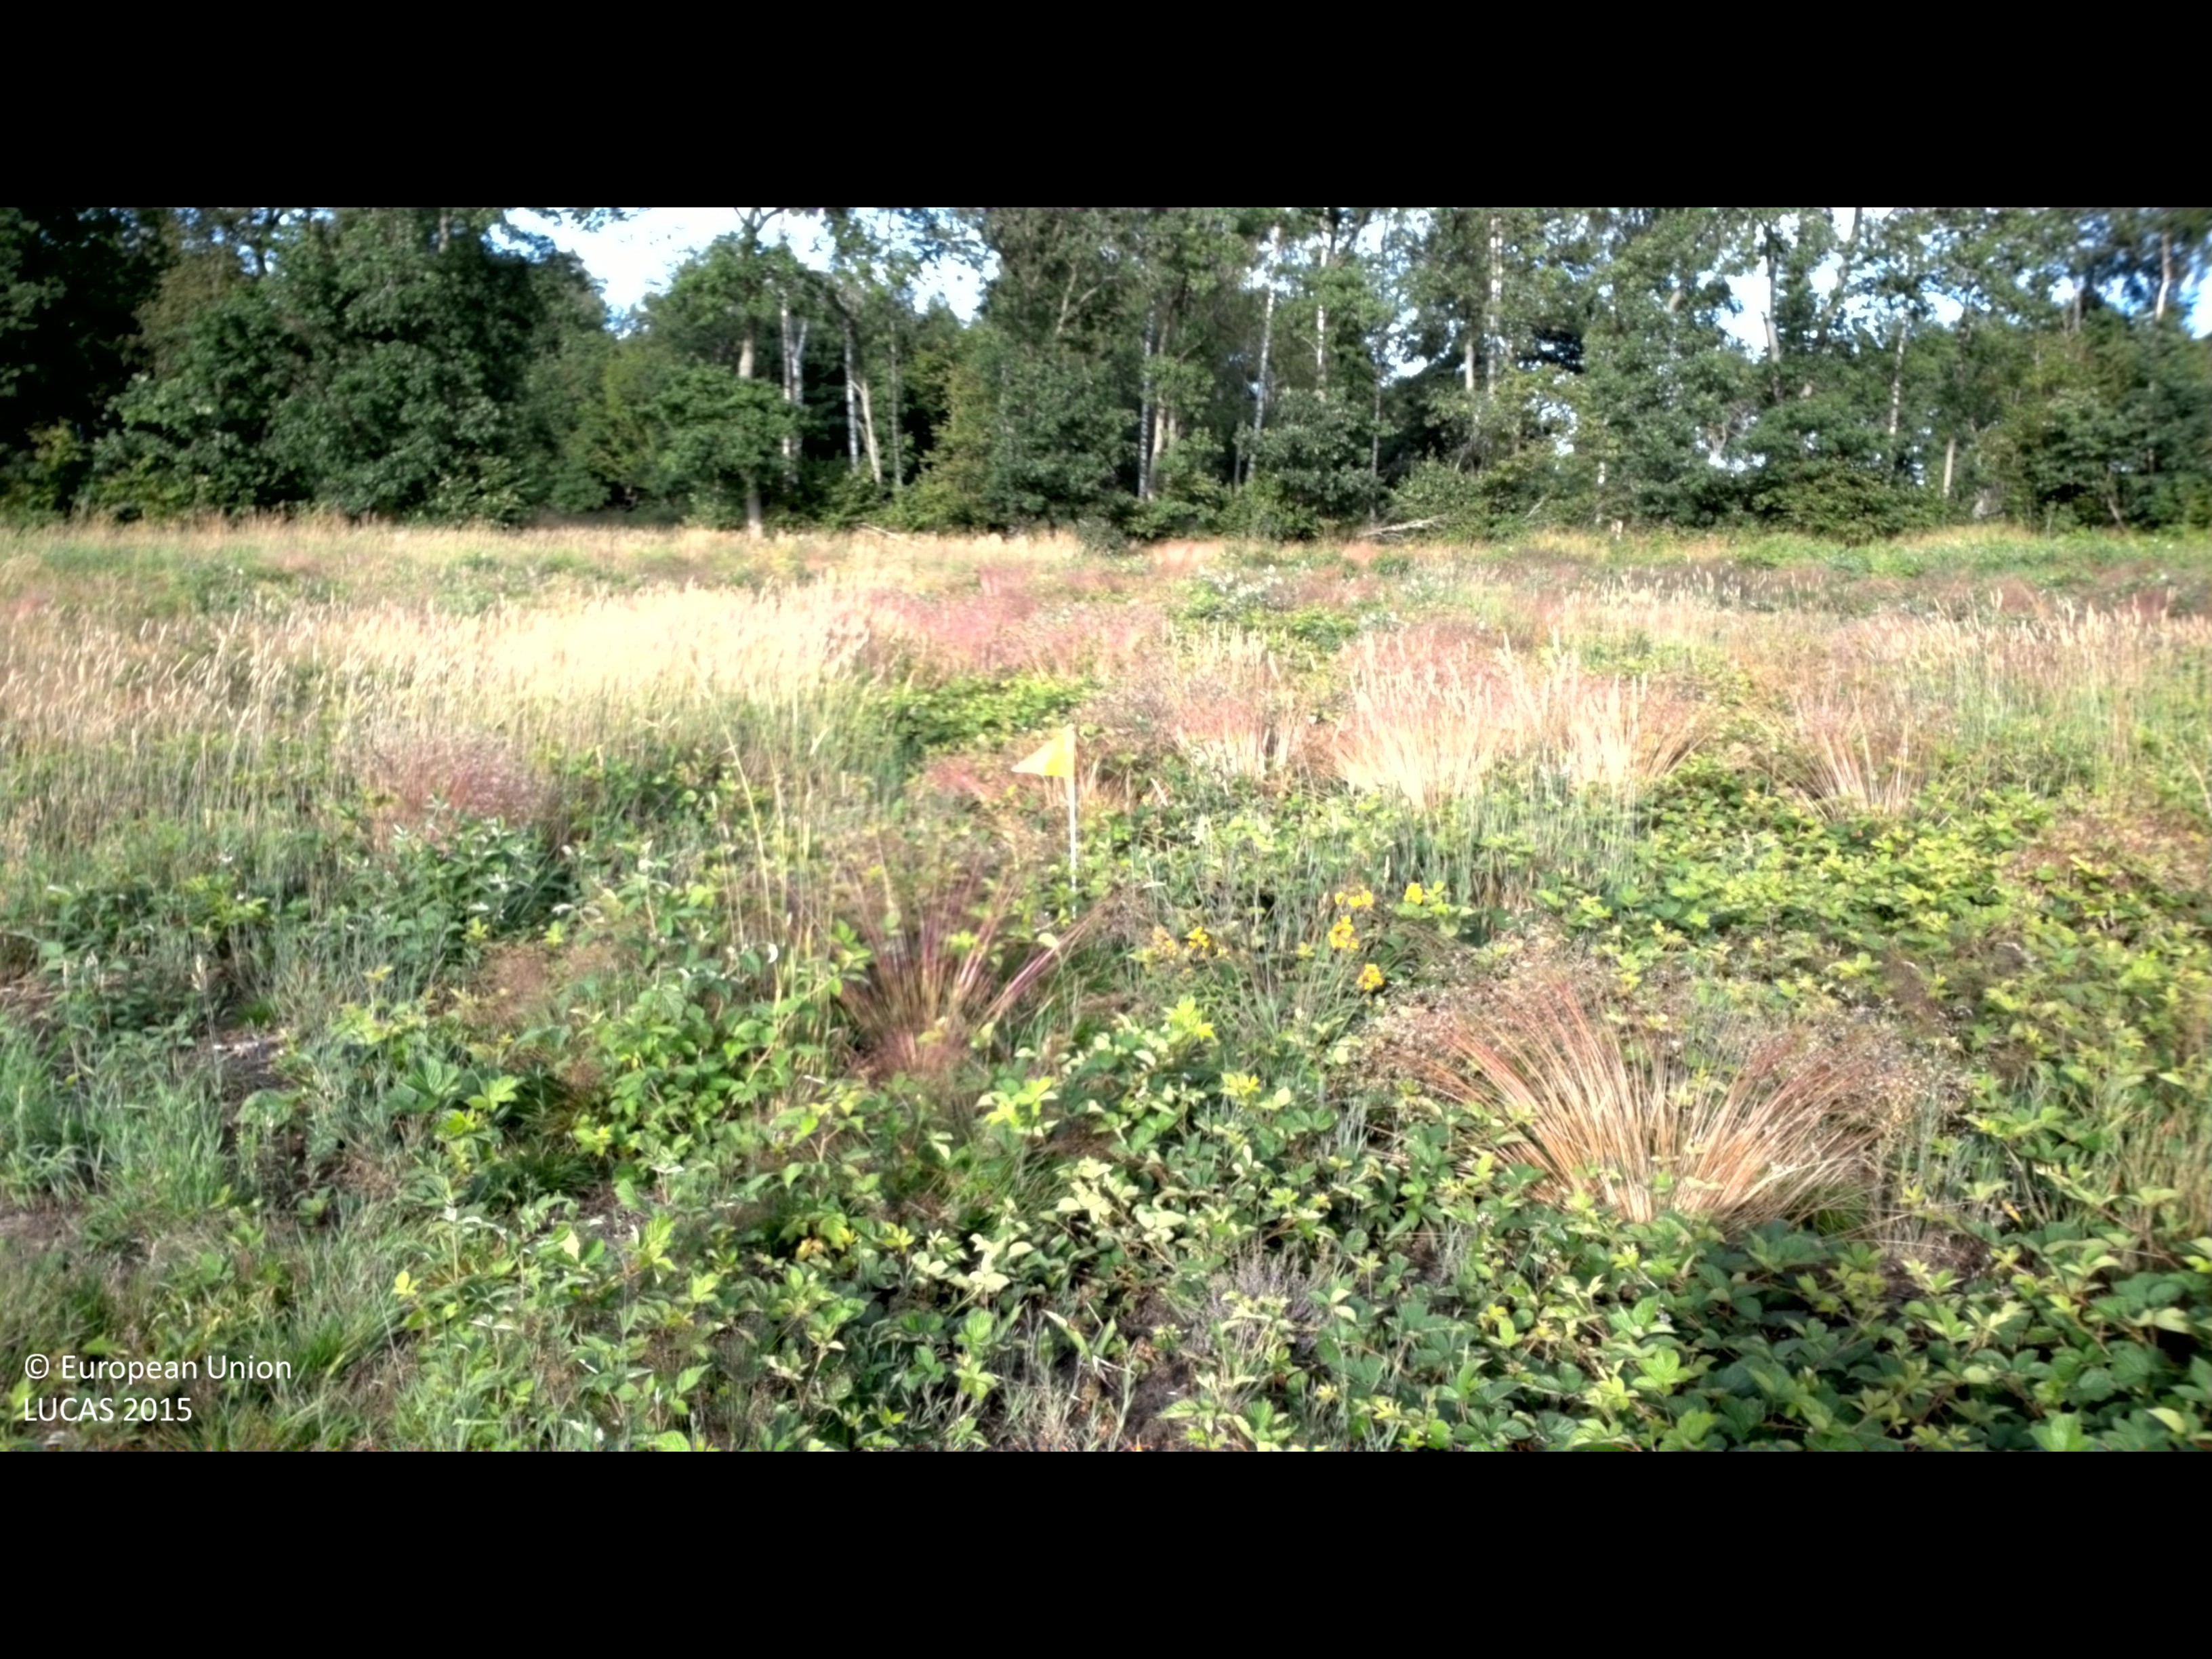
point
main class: Shrubland
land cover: Shrubland without tree cover
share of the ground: > 75 %
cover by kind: shrubs 85 %, herbaceous plants 15 %
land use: Semi-natural and natural areas not in use
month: July
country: SE
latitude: 57.1524
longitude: 16.9943
